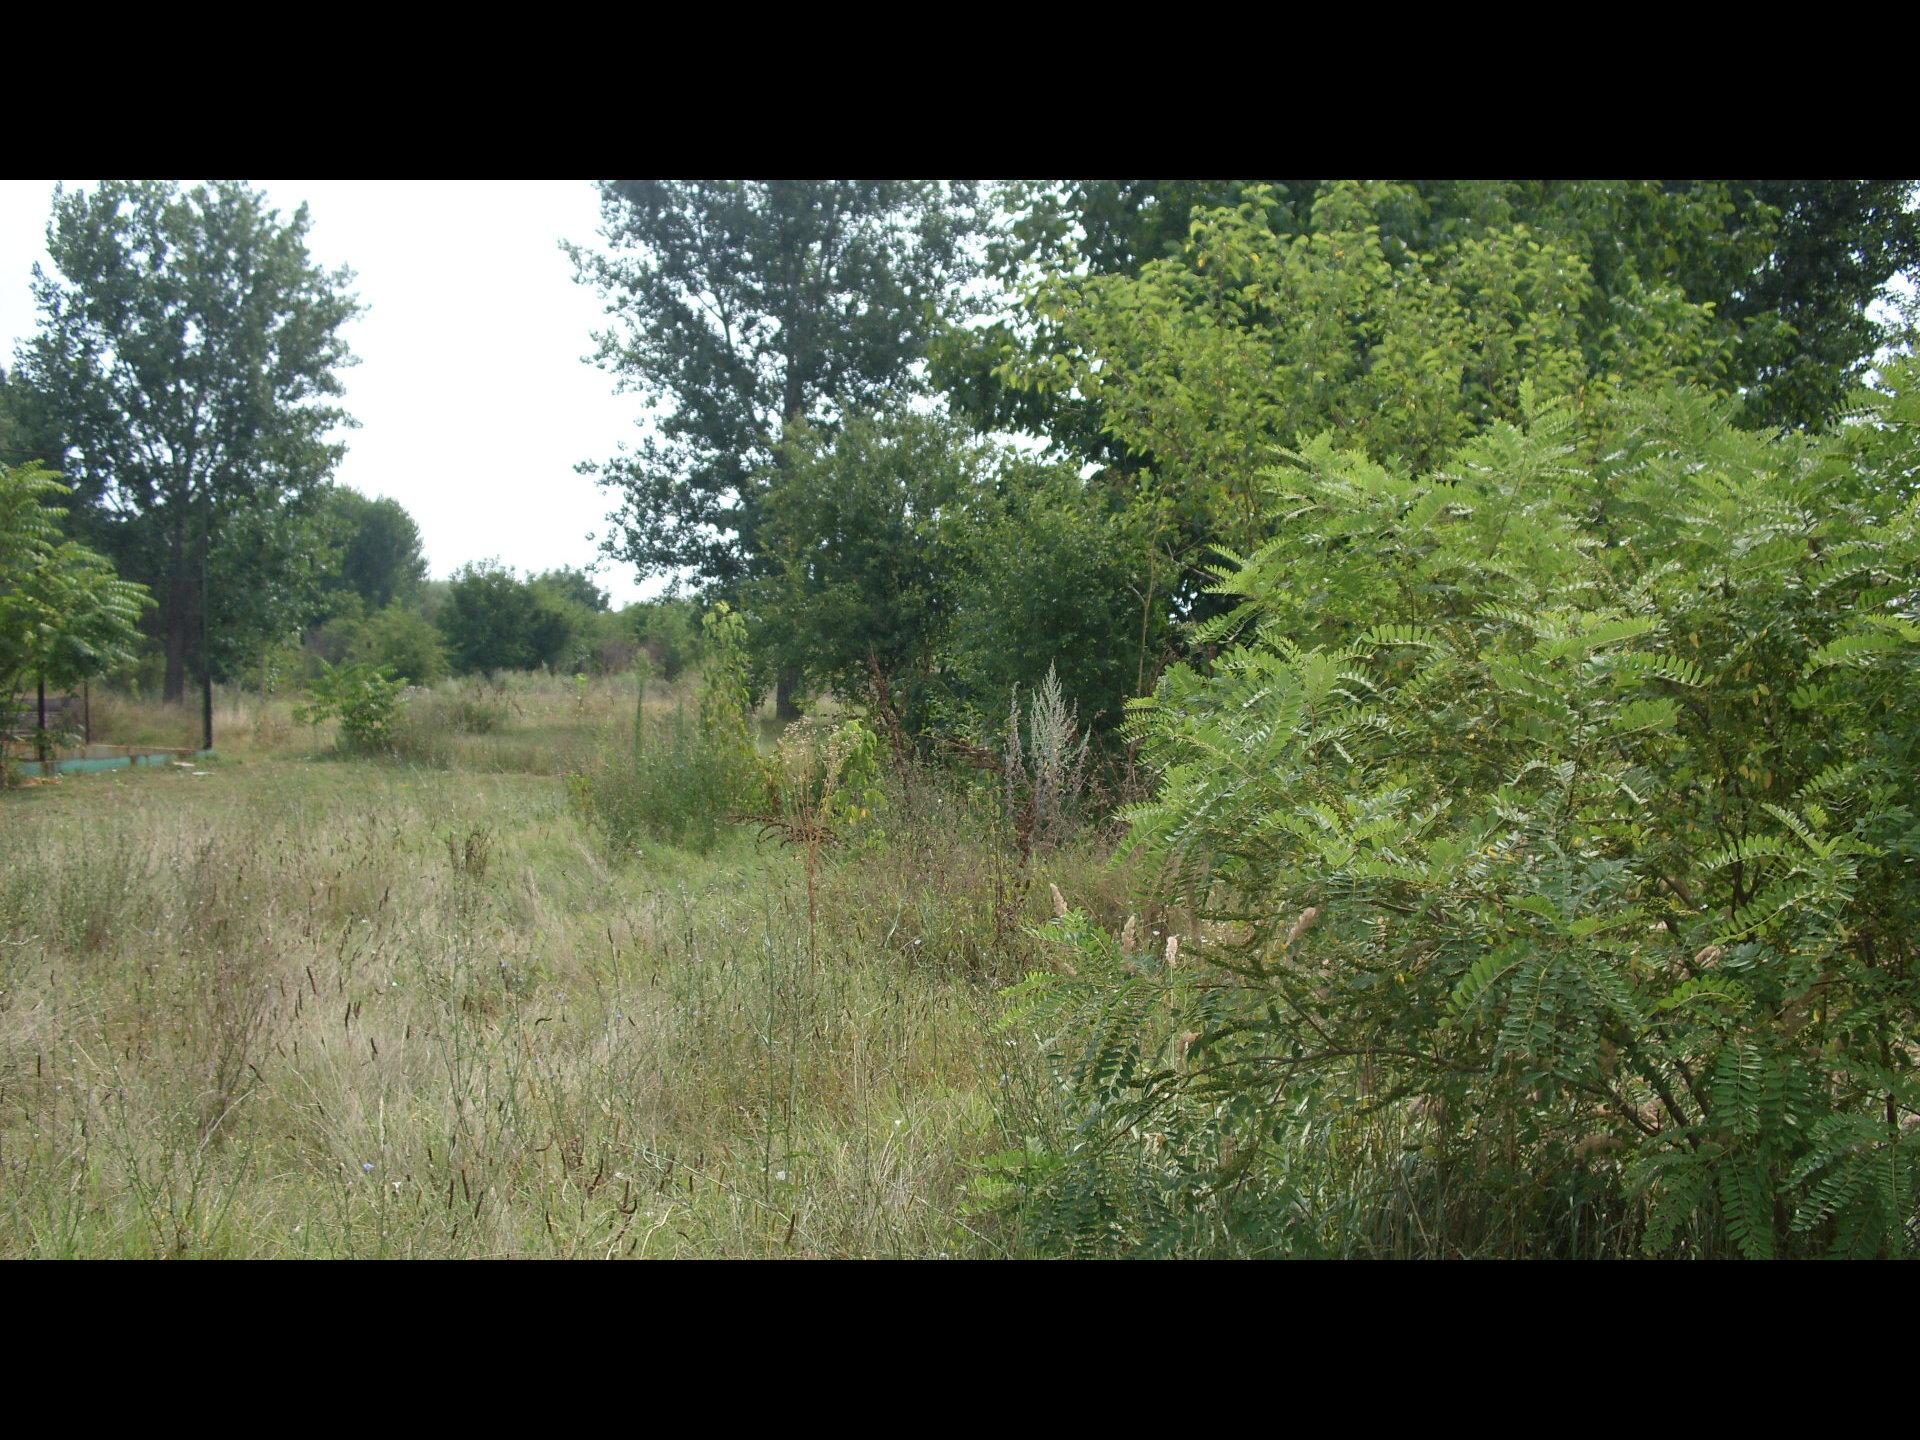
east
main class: Grassland
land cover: Grassland with sparse tree/shrub cover
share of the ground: > 75 %
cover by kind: herbaceous plants 85 %, shrubs 10 %, broadleaved forest trees 5 %
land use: Abandoned areas
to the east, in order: Grassland with sparse tree/shrub cover; Grassland without tree/shrub cover; Tracks; Grassland without tree/shrub cover; Shrubland with sparse tree cover; Broadleaved woodland; Grassland with sparse tree/shrub cover
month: July
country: BG
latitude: 43.7800
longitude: 23.7309
